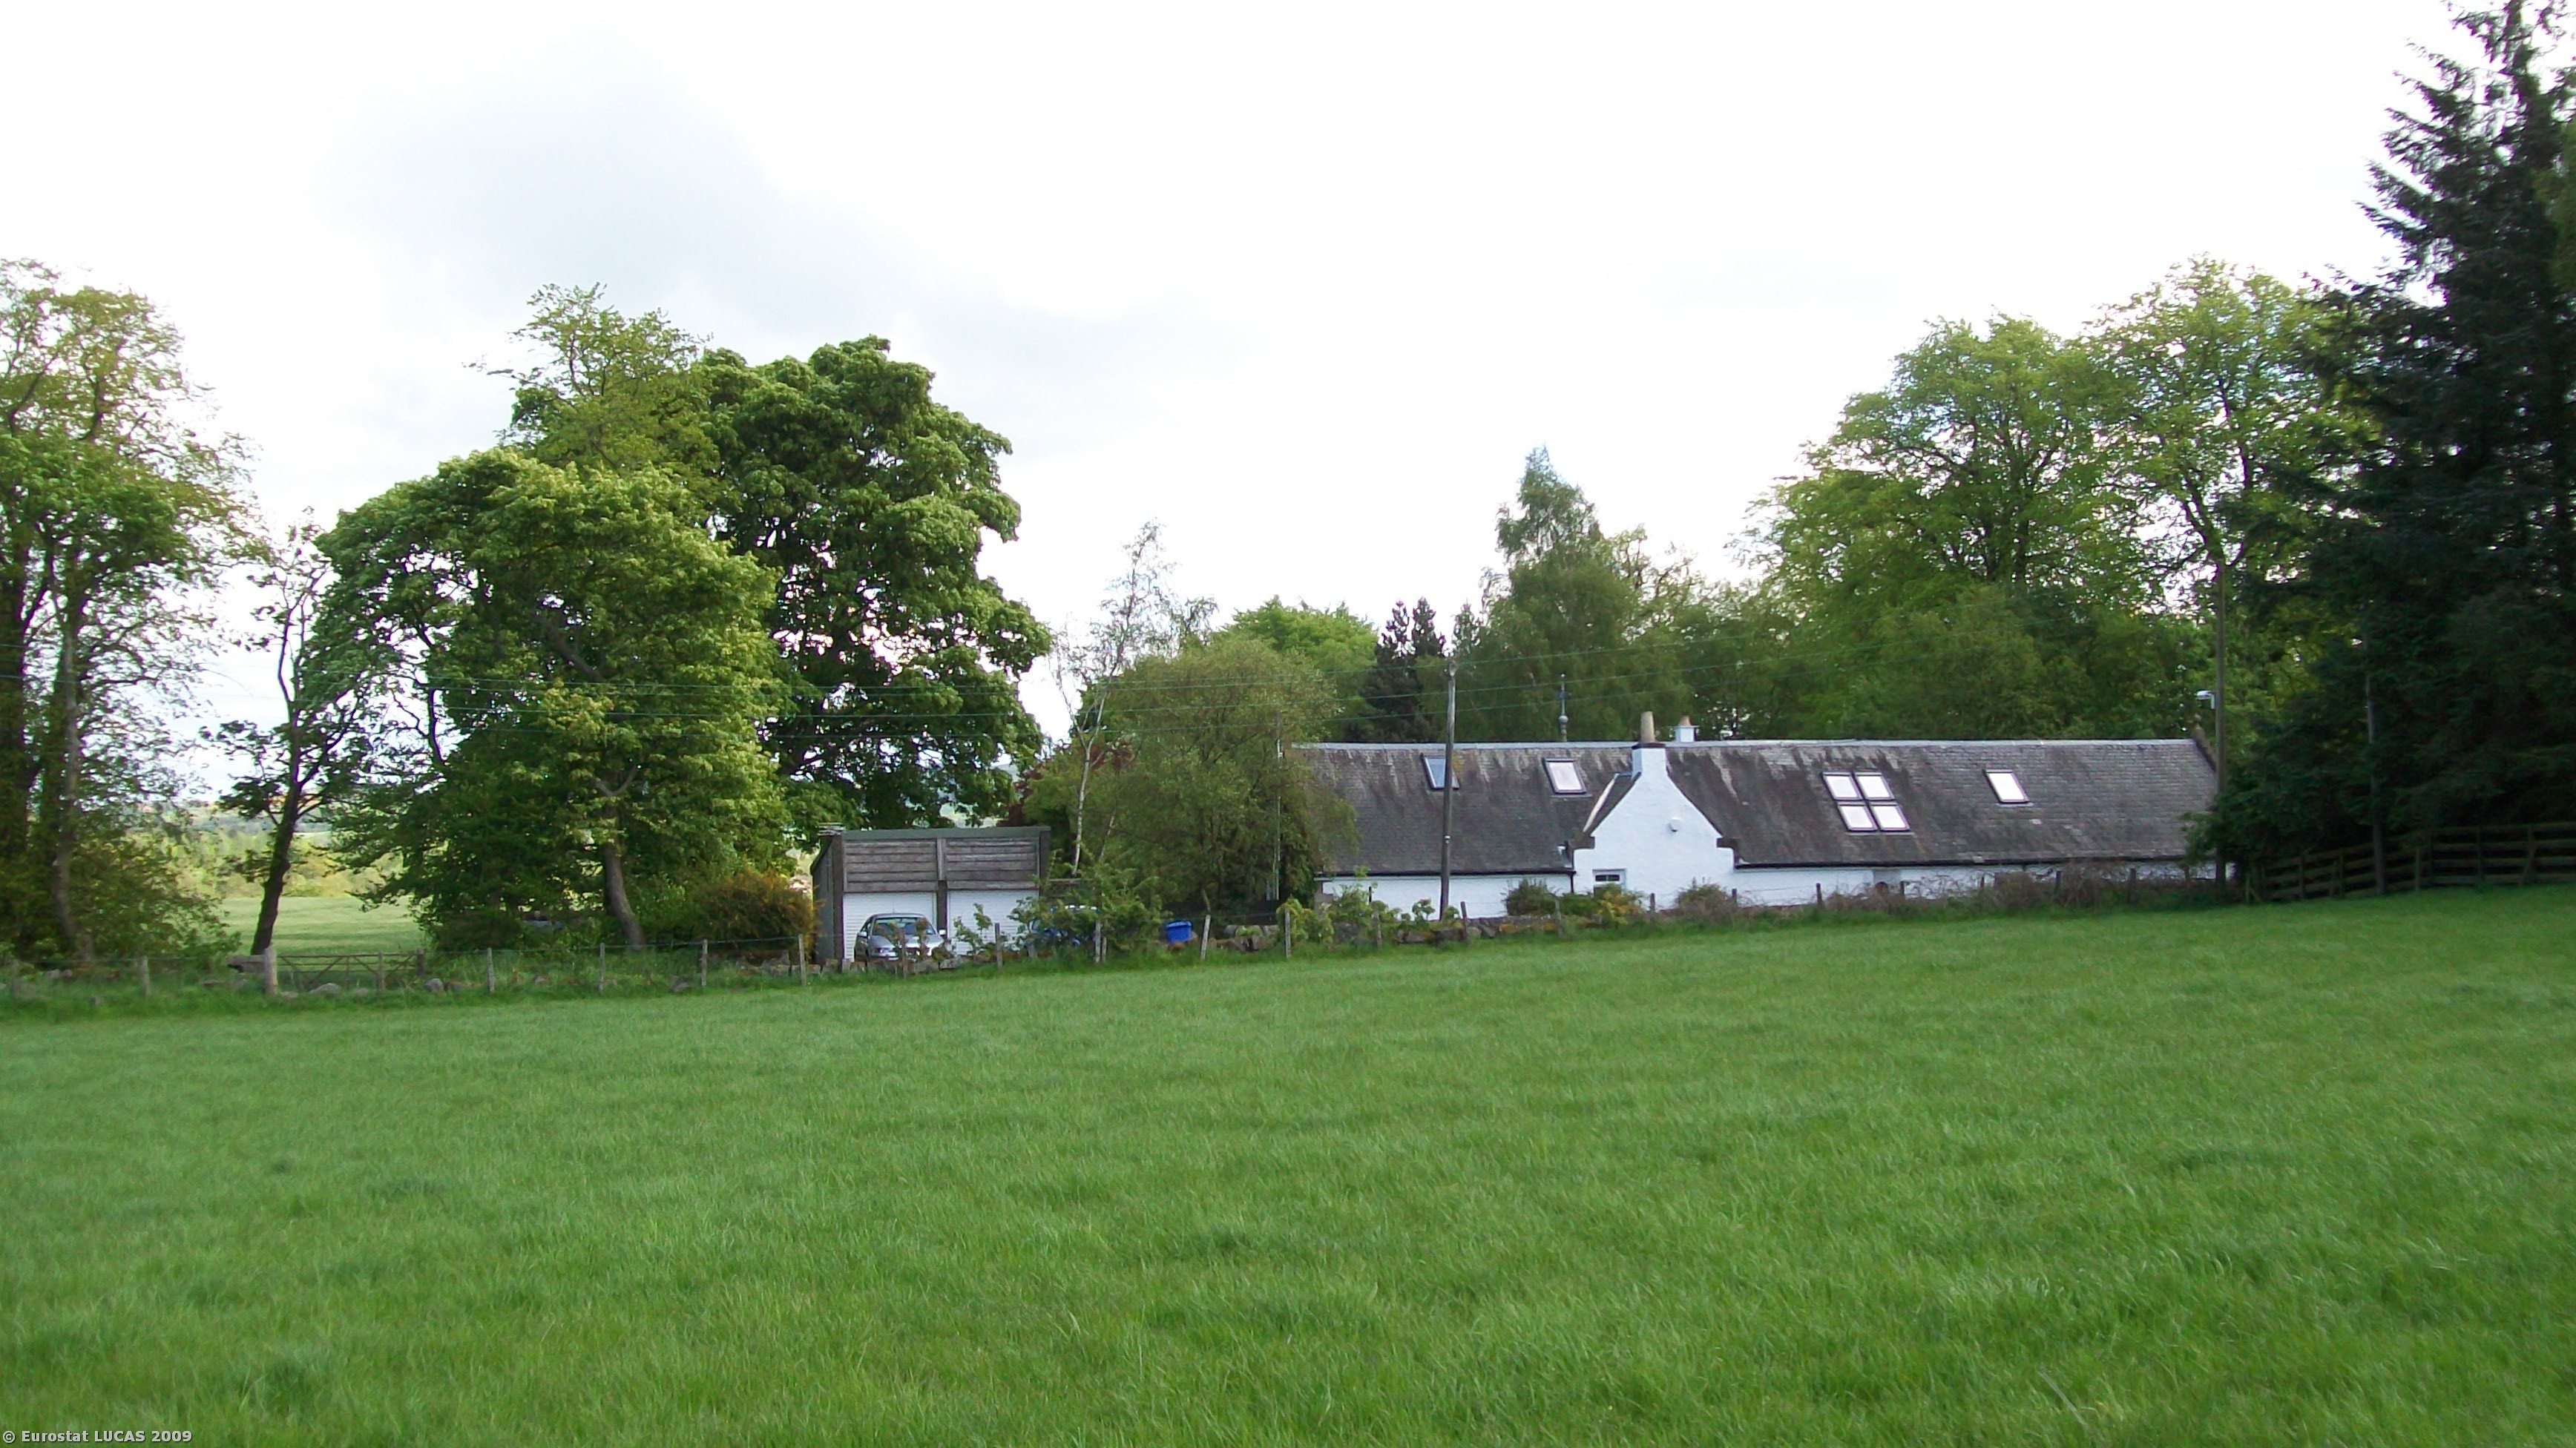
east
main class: Grassland
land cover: Grassland without tree/shrub cover
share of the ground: > 75 %
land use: Agriculture (excluding fallow land and kitchen gardens)
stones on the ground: < 10 %
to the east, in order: Grassland without tree/shrub cover; Fences; Dry stone walls; Grass margins; Paved roads, cycling and walking lanes; Grass margins; Artificial constructions in urban areas; Fences; Grass margins; Barley; Grass margins; Fences; Lines of trees; Grass margins; Tracks; Grass margins; Artificial constructions; Fences; Grassland without tree/shrub cover; Broadleaved woodland; Managed hedges
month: May
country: GB
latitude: 55.9232
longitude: -3.6999
